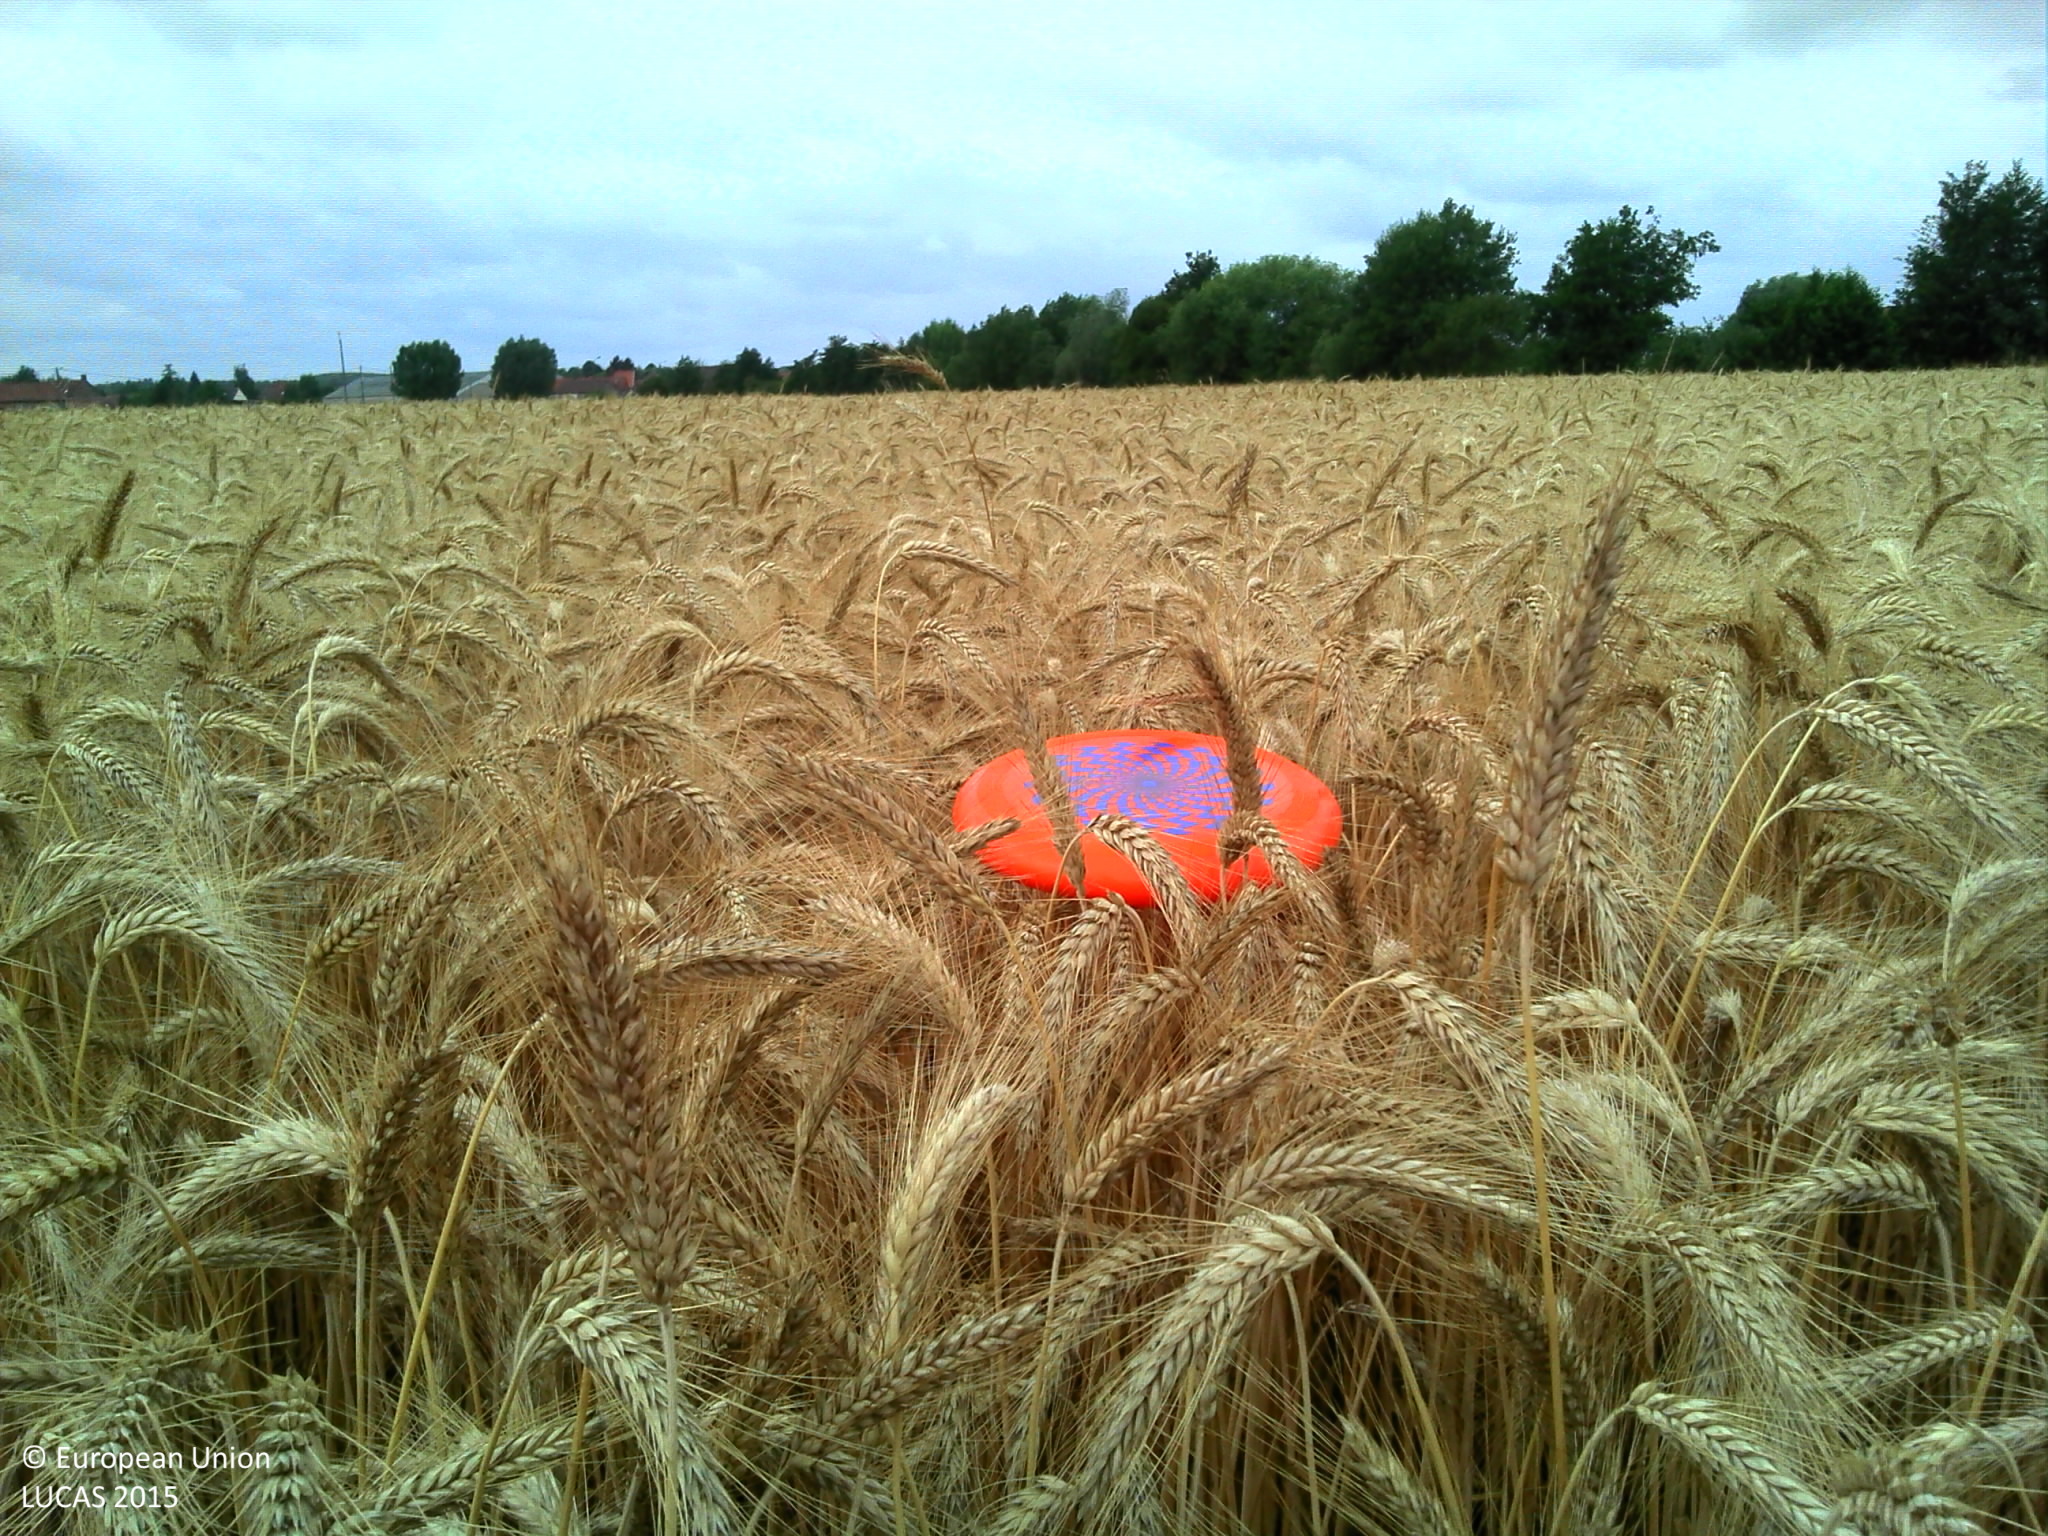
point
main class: Cropland
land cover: Triticale
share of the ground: > 75 %
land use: Agriculture (excluding fallow land and kitchen gardens)
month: July
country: FR
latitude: 50.4480
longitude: 3.1606
